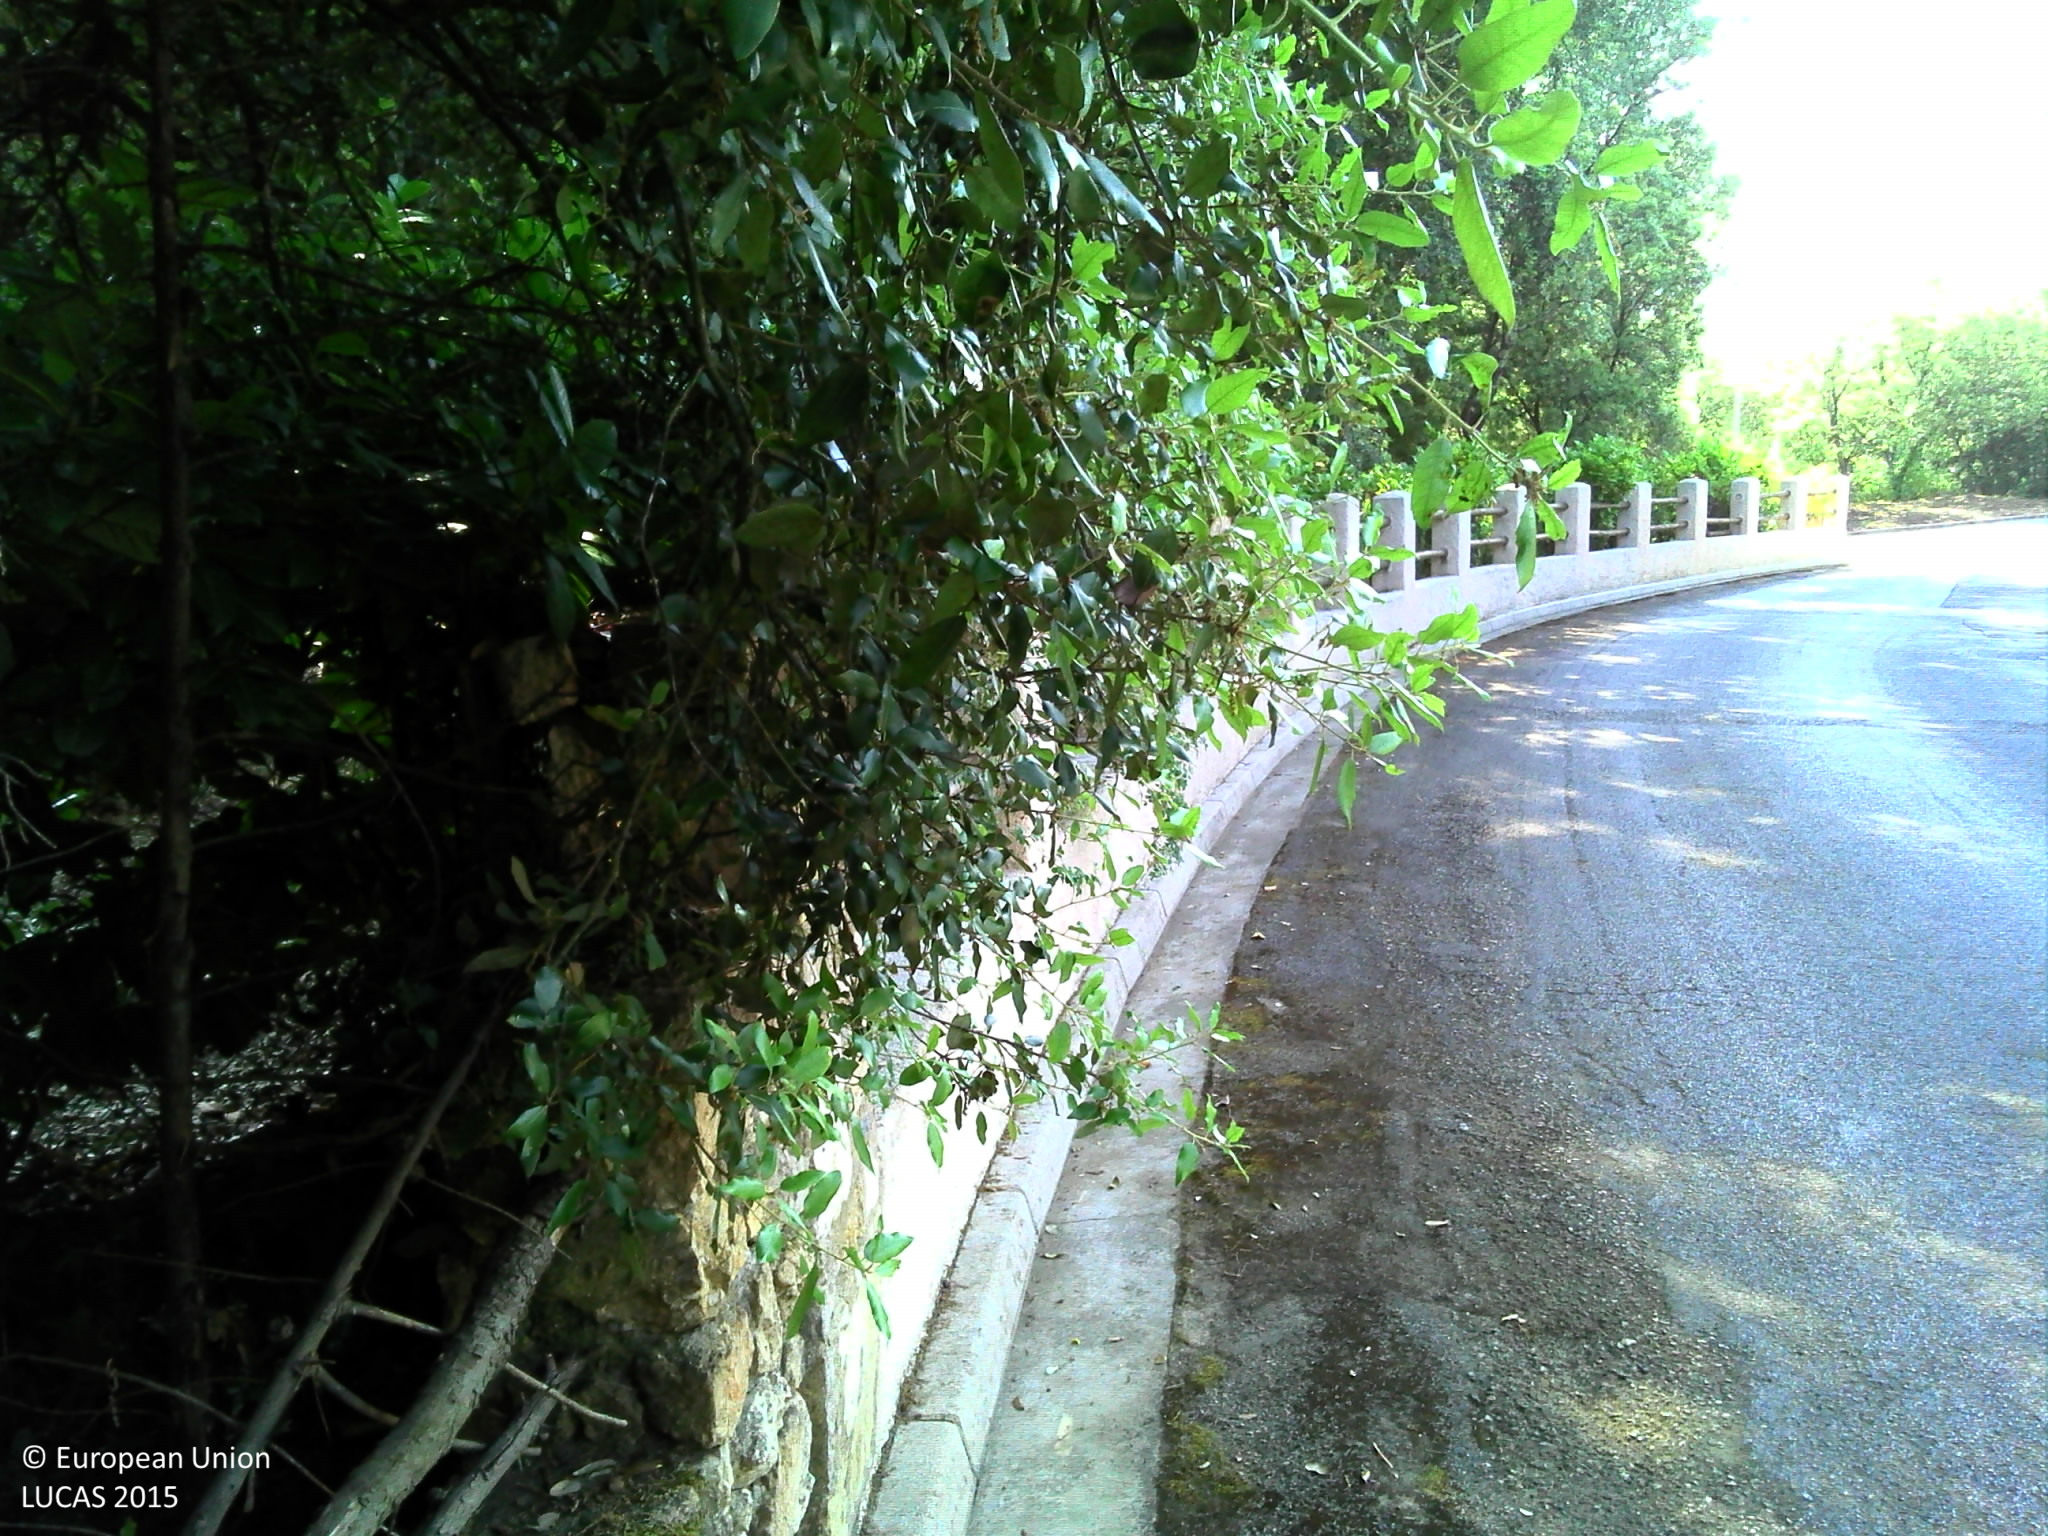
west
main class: Woodland
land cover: Pine dominated mixed woodland
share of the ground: > 75 %
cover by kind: coniferous forest trees 40 %, broadleaved forest trees 40 %, herbaceous plants 20 %
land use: Residential
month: June
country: FR
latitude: 43.6586
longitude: 7.0436
